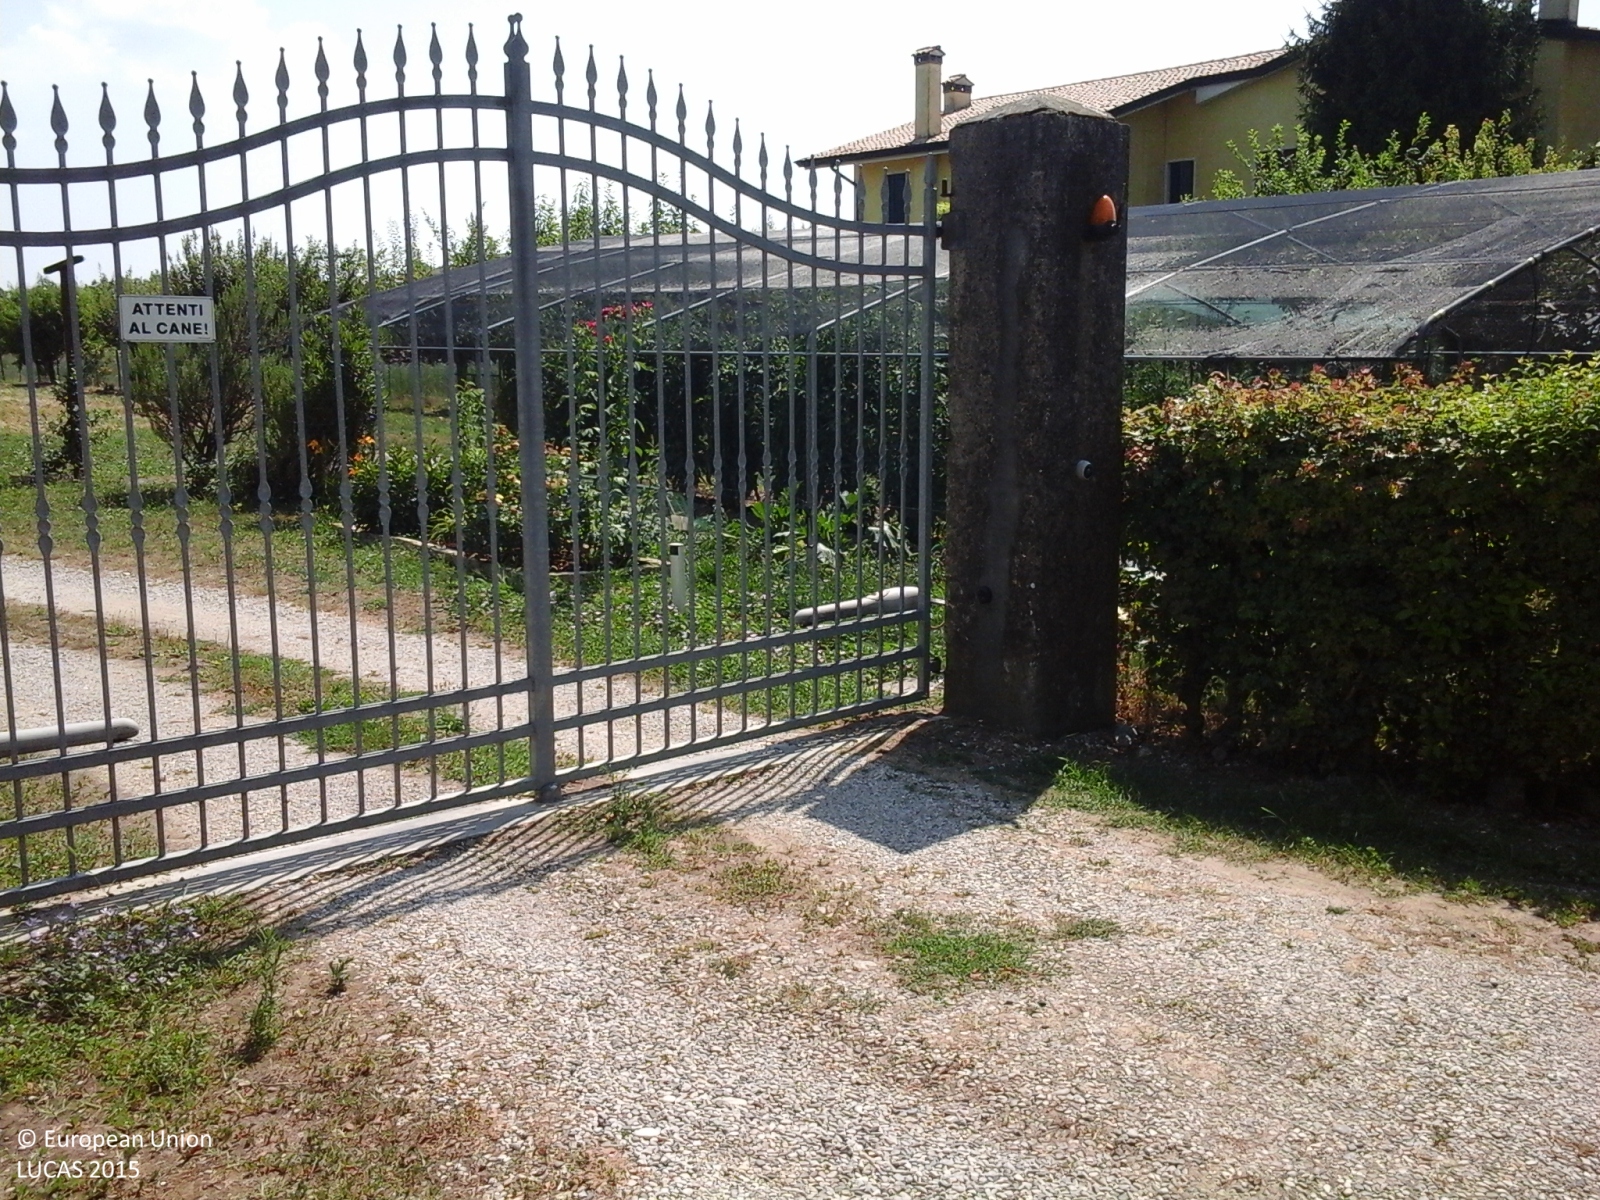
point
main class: Shrubland
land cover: Shrubland without tree cover
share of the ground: > 75 %
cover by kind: shrubs 90 %, herbaceous plants 10 %
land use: Residential
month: June
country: IT
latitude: 45.6958
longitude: 12.2954
